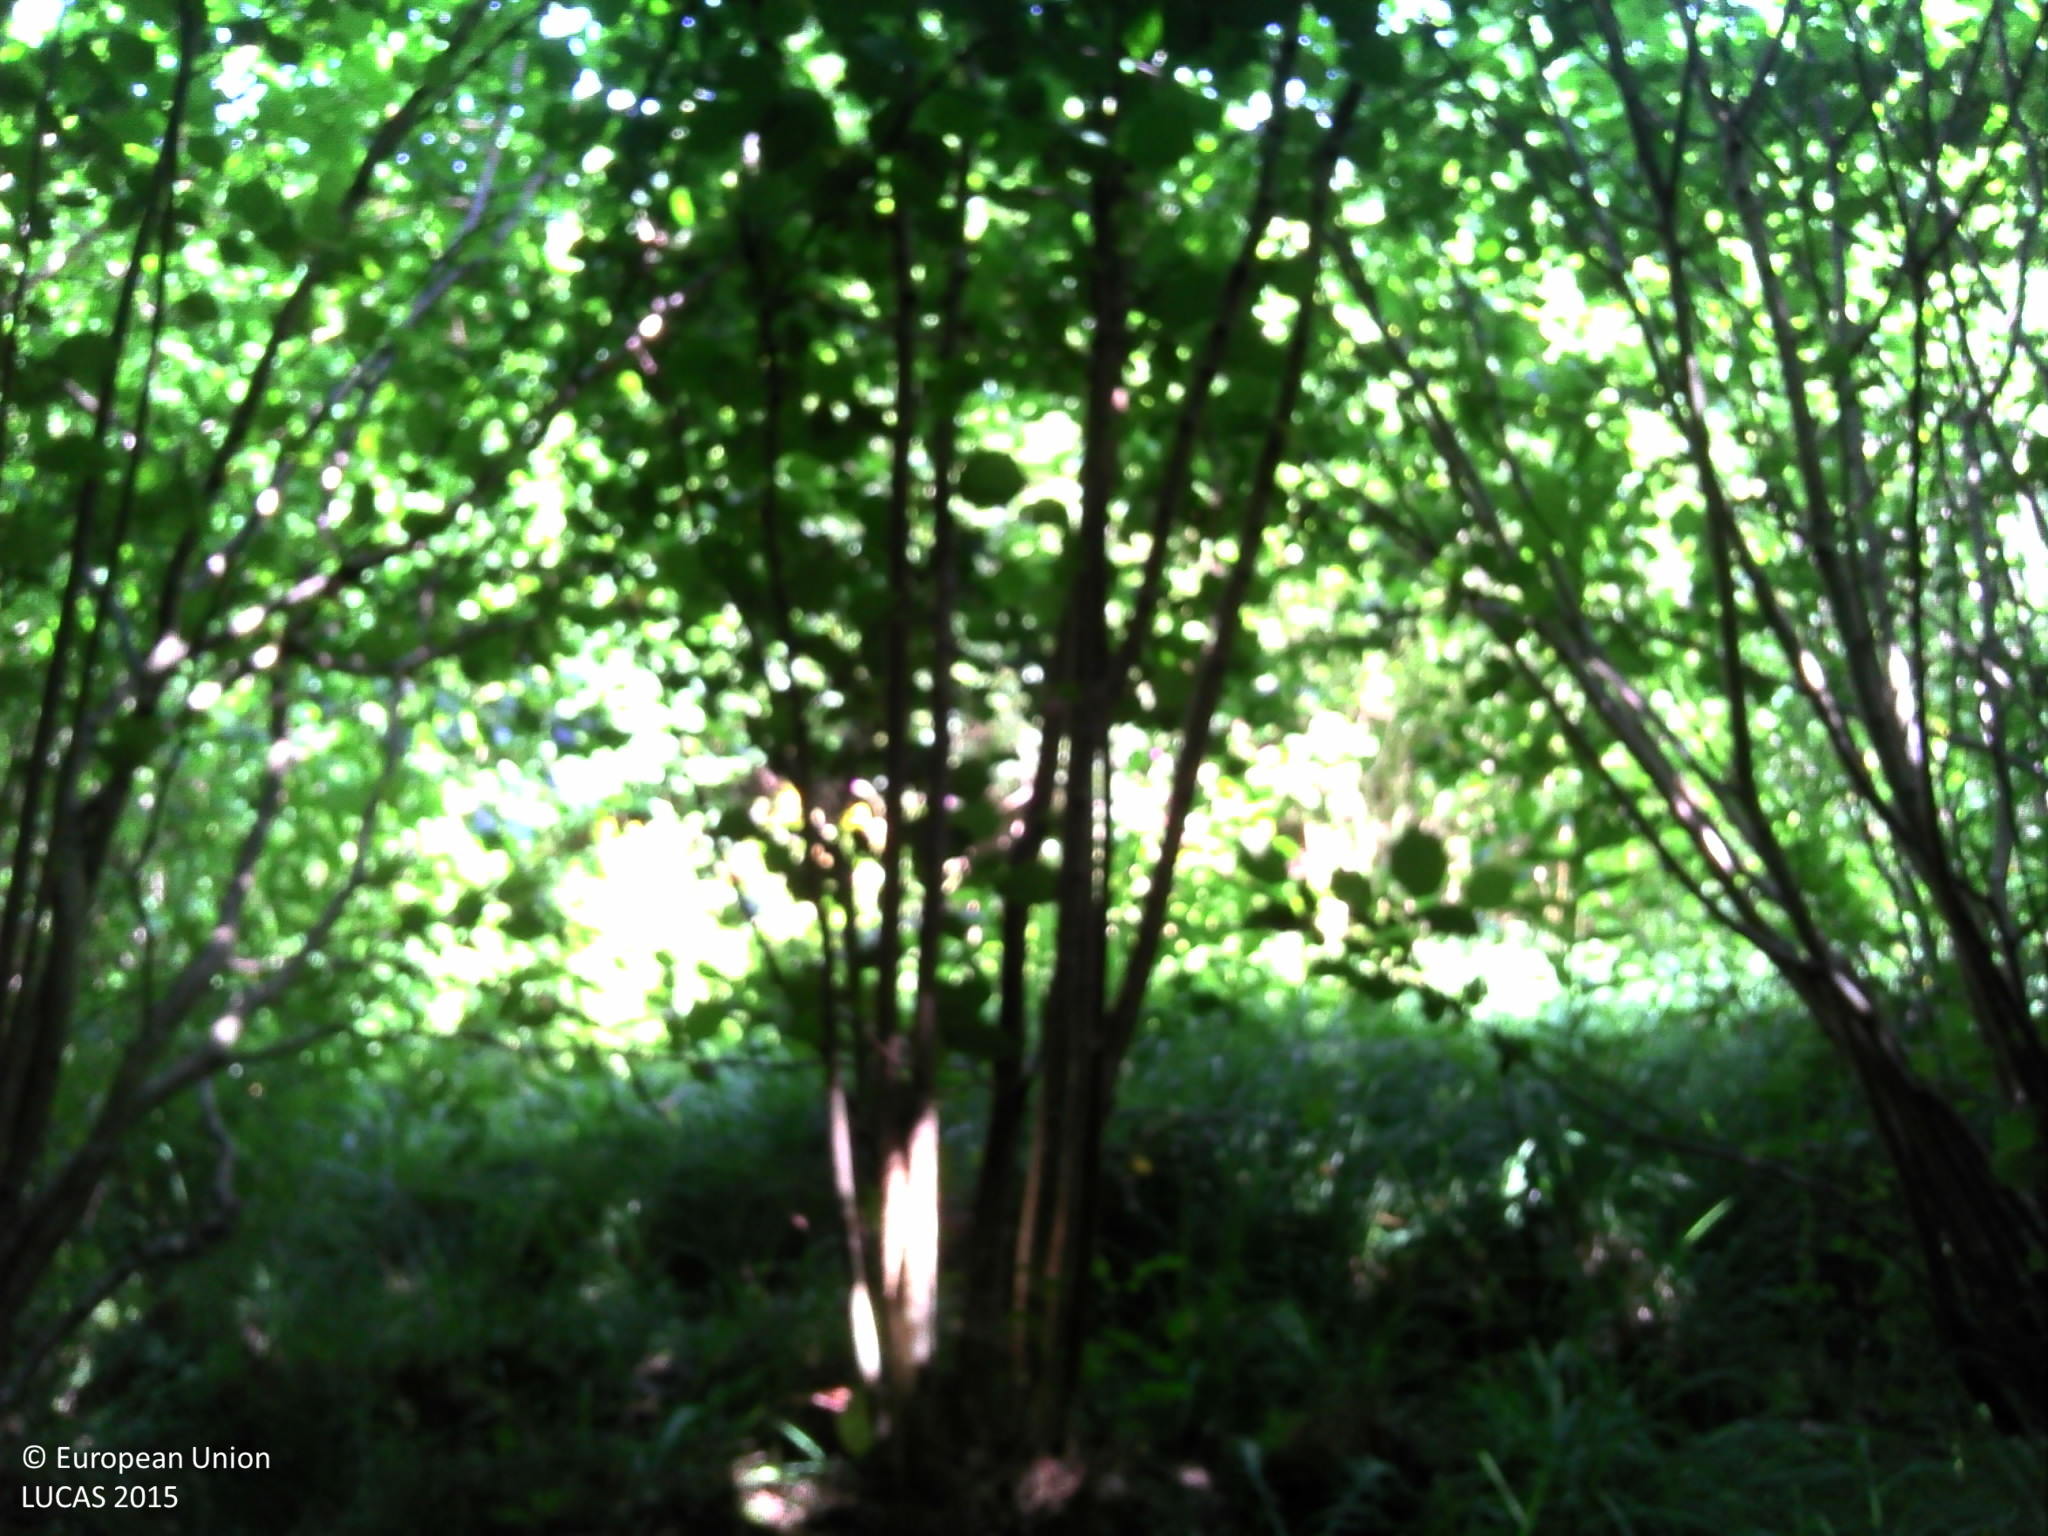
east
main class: Woodland
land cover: Broadleaved woodland
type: mesophytic deciduous forest
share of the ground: > 75 %
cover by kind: broadleaved forest trees 100 %
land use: Forestry
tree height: > 5 m
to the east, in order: Broadleaved woodland; Grassland without tree/shrub cover; Broadleaved woodland; Grassland without tree/shrub cover; Broadleaved woodland
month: July
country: FR
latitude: 43.6321
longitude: 2.5823
